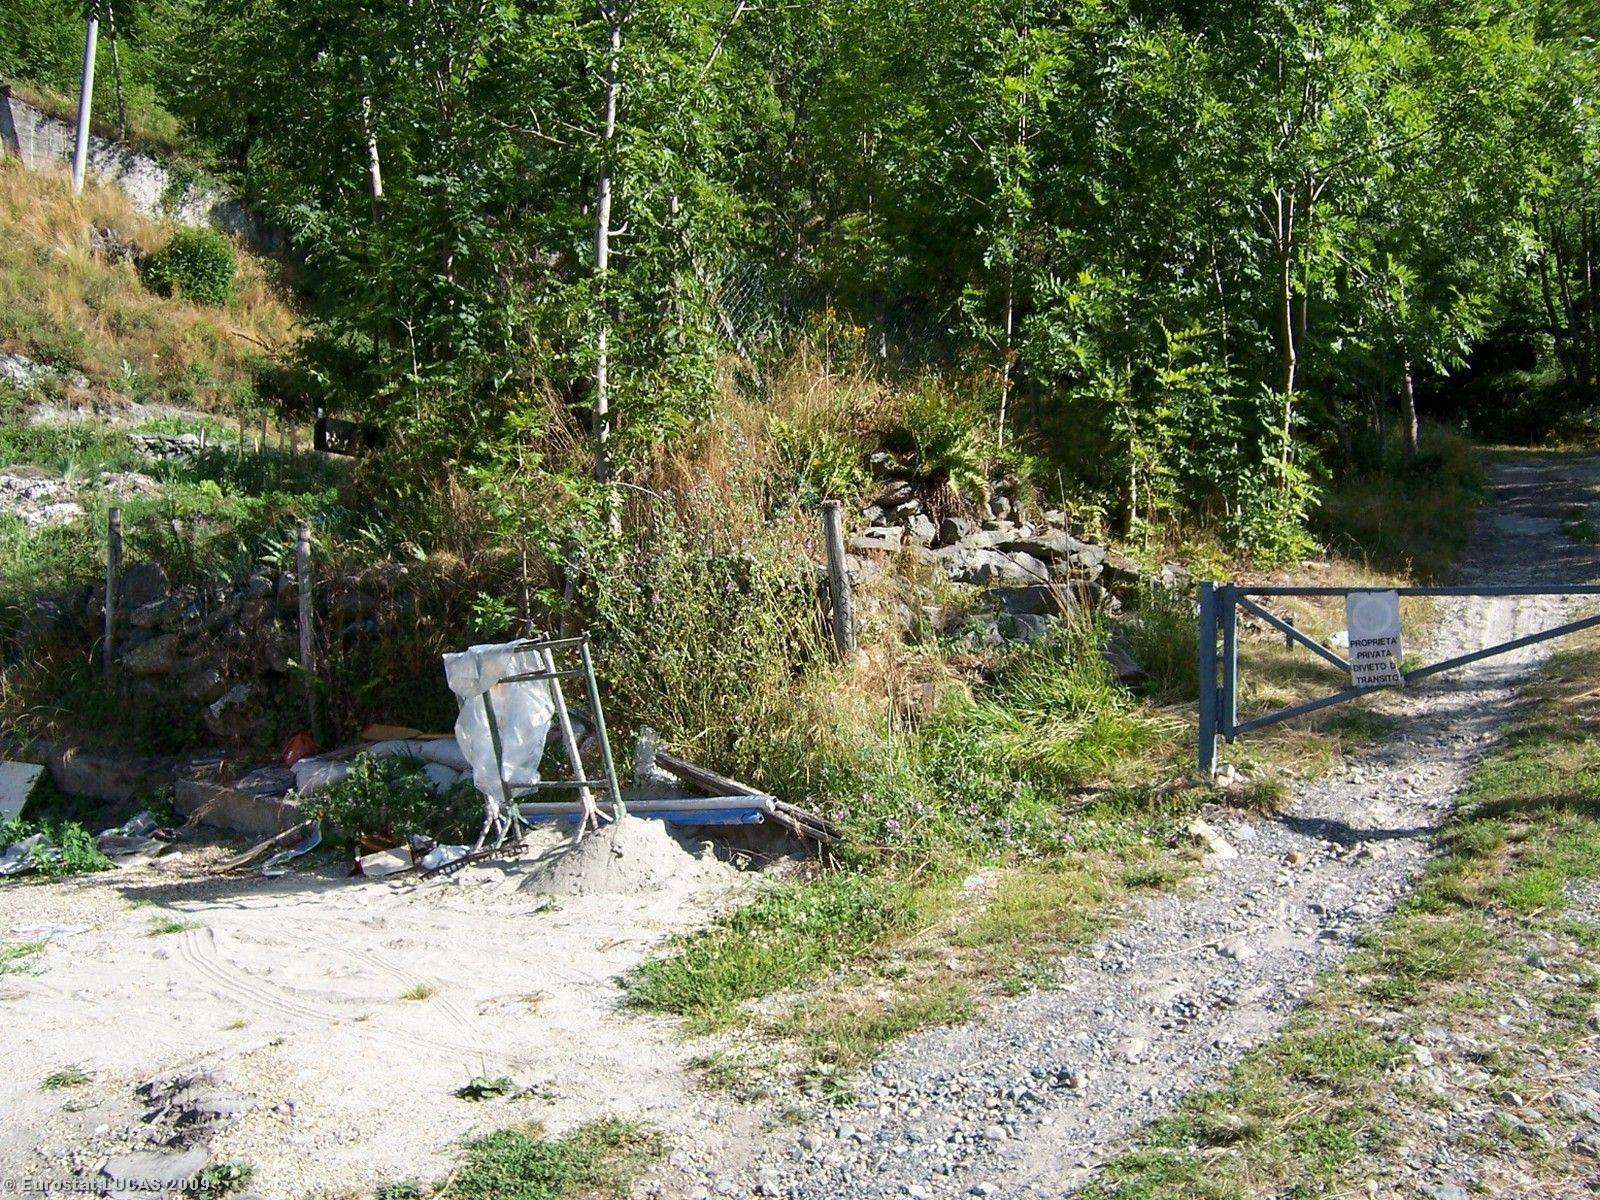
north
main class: Woodland
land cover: Broadleaved woodland
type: mesophytic deciduous forest
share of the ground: > 75 %
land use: Unused
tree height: > 5 m
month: July
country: IT
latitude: 45.3272
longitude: 7.3631
